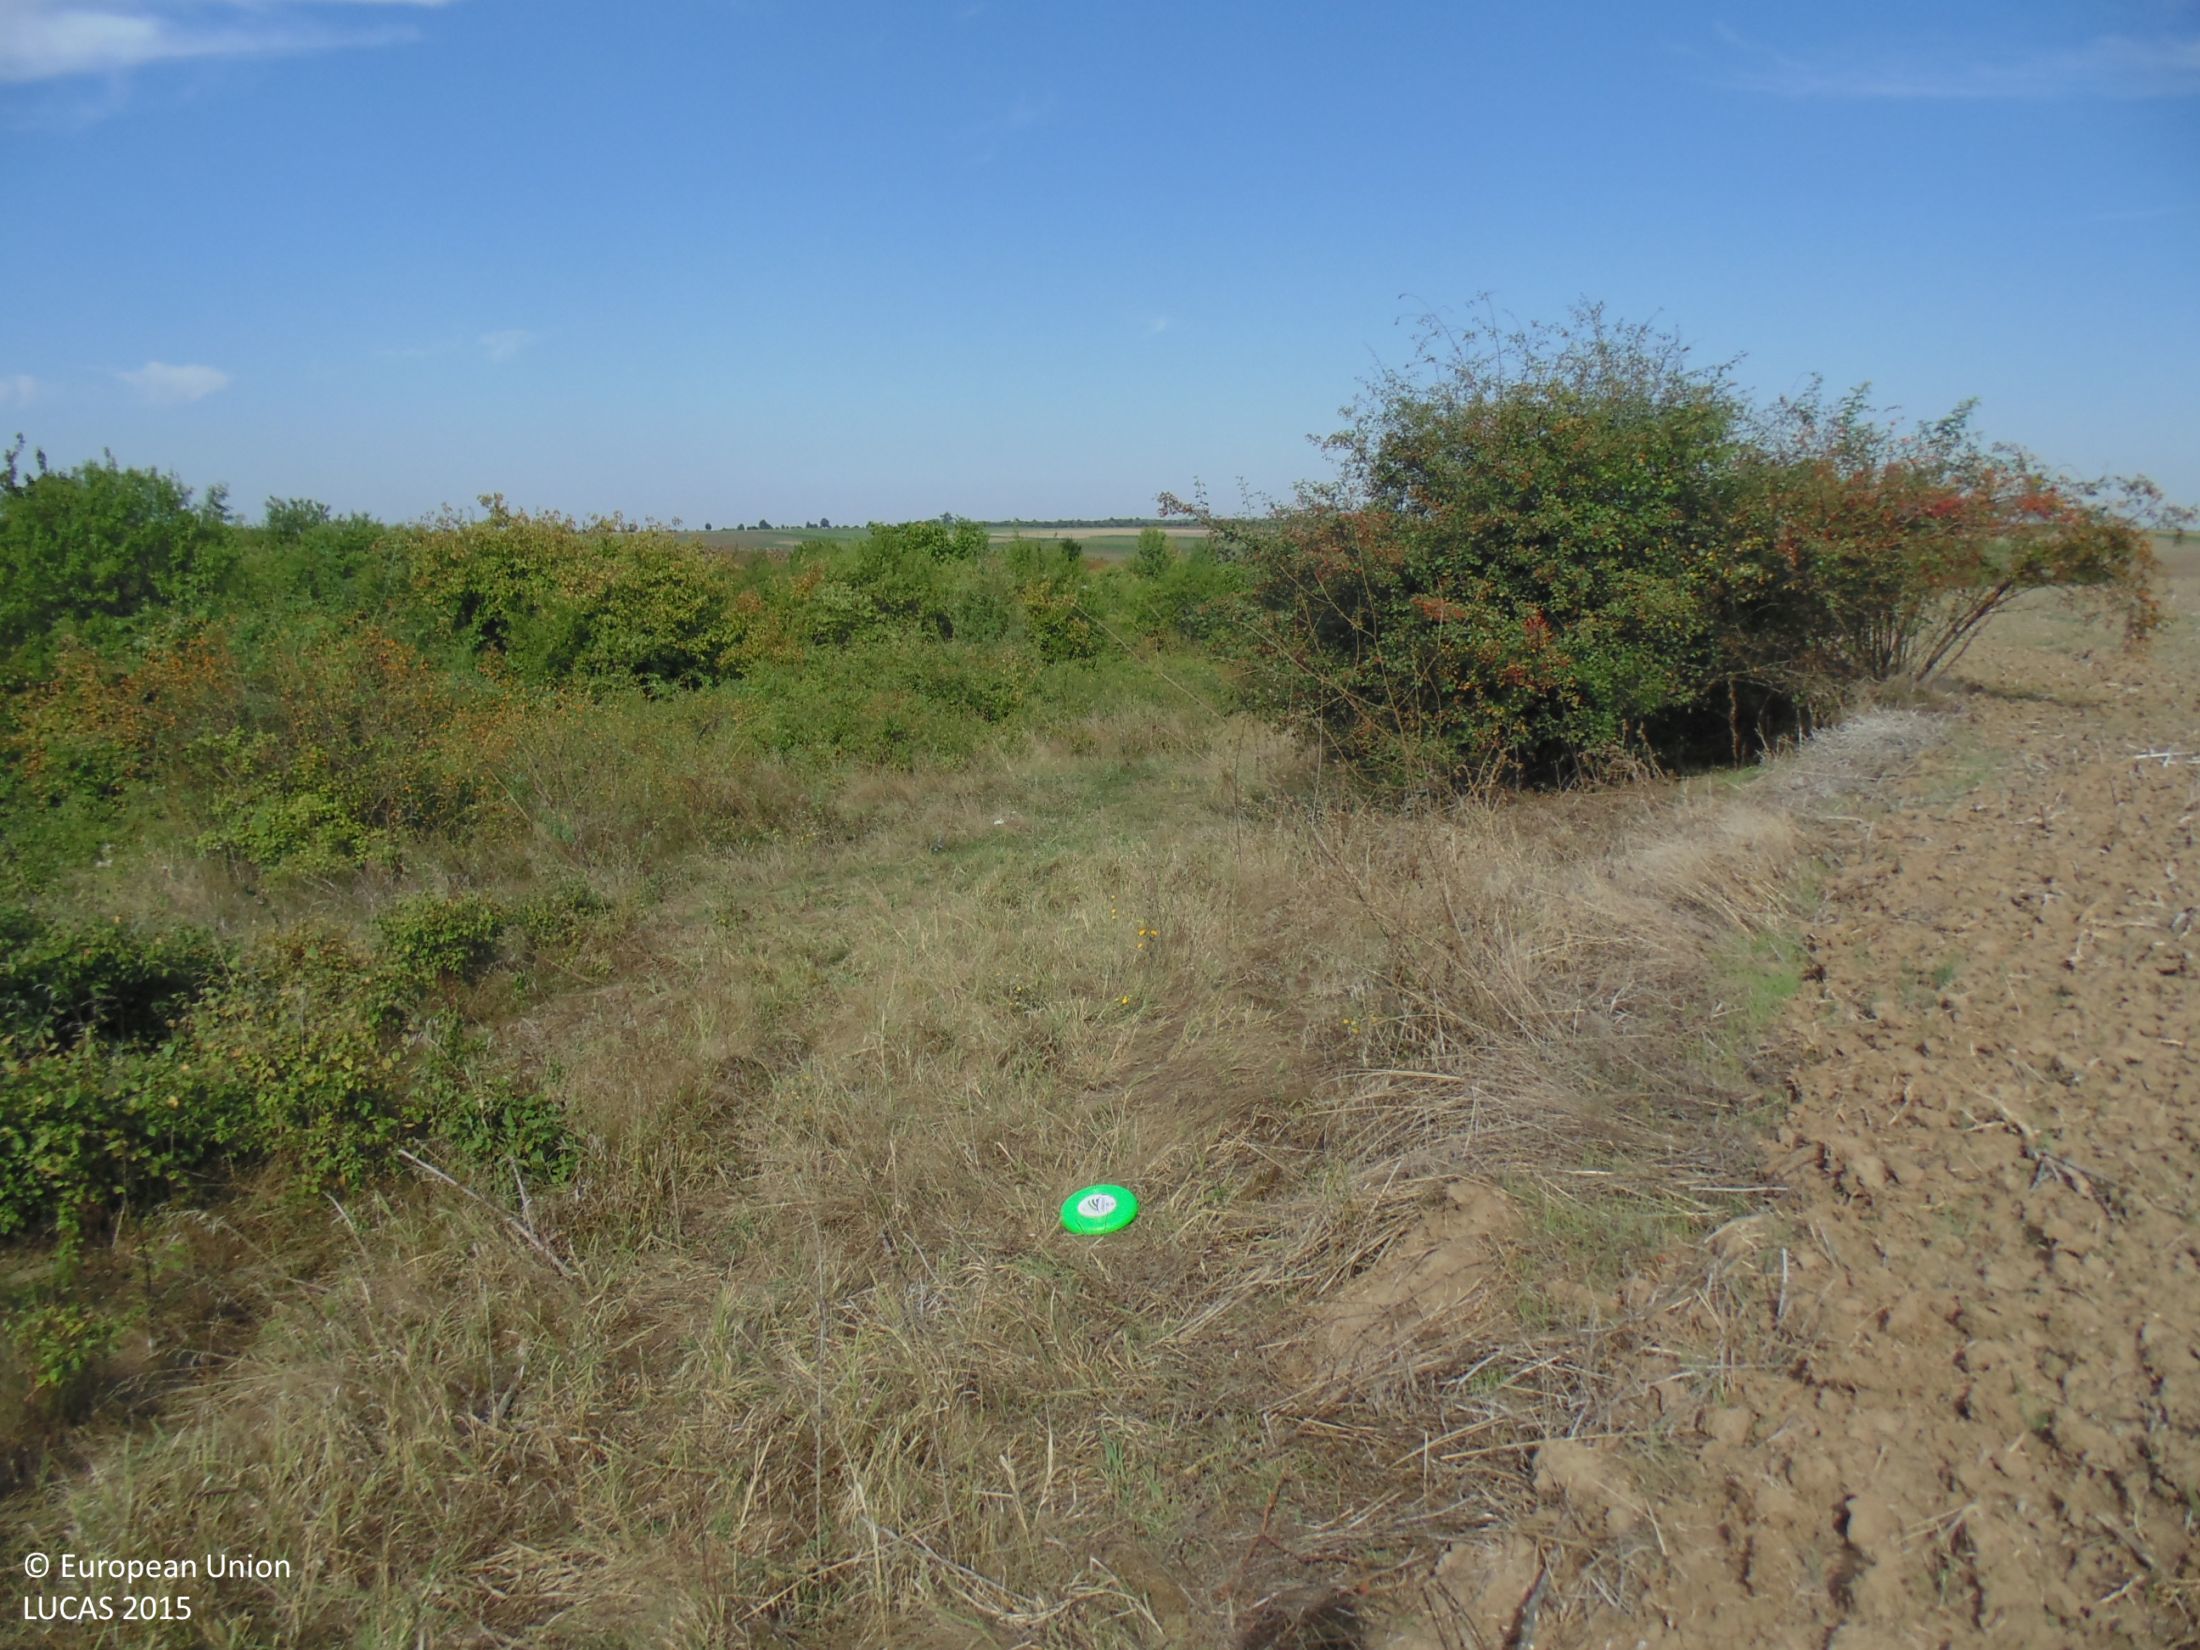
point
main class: Grassland
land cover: Grassland with sparse tree/shrub cover
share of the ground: > 75 %
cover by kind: herbaceous plants 90 %, broadleaved forest trees 5 %, shrubs 5 %
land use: Semi-natural and natural areas not in use
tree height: < 5 m
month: September
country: BG
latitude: 43.8518
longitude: 27.1305
